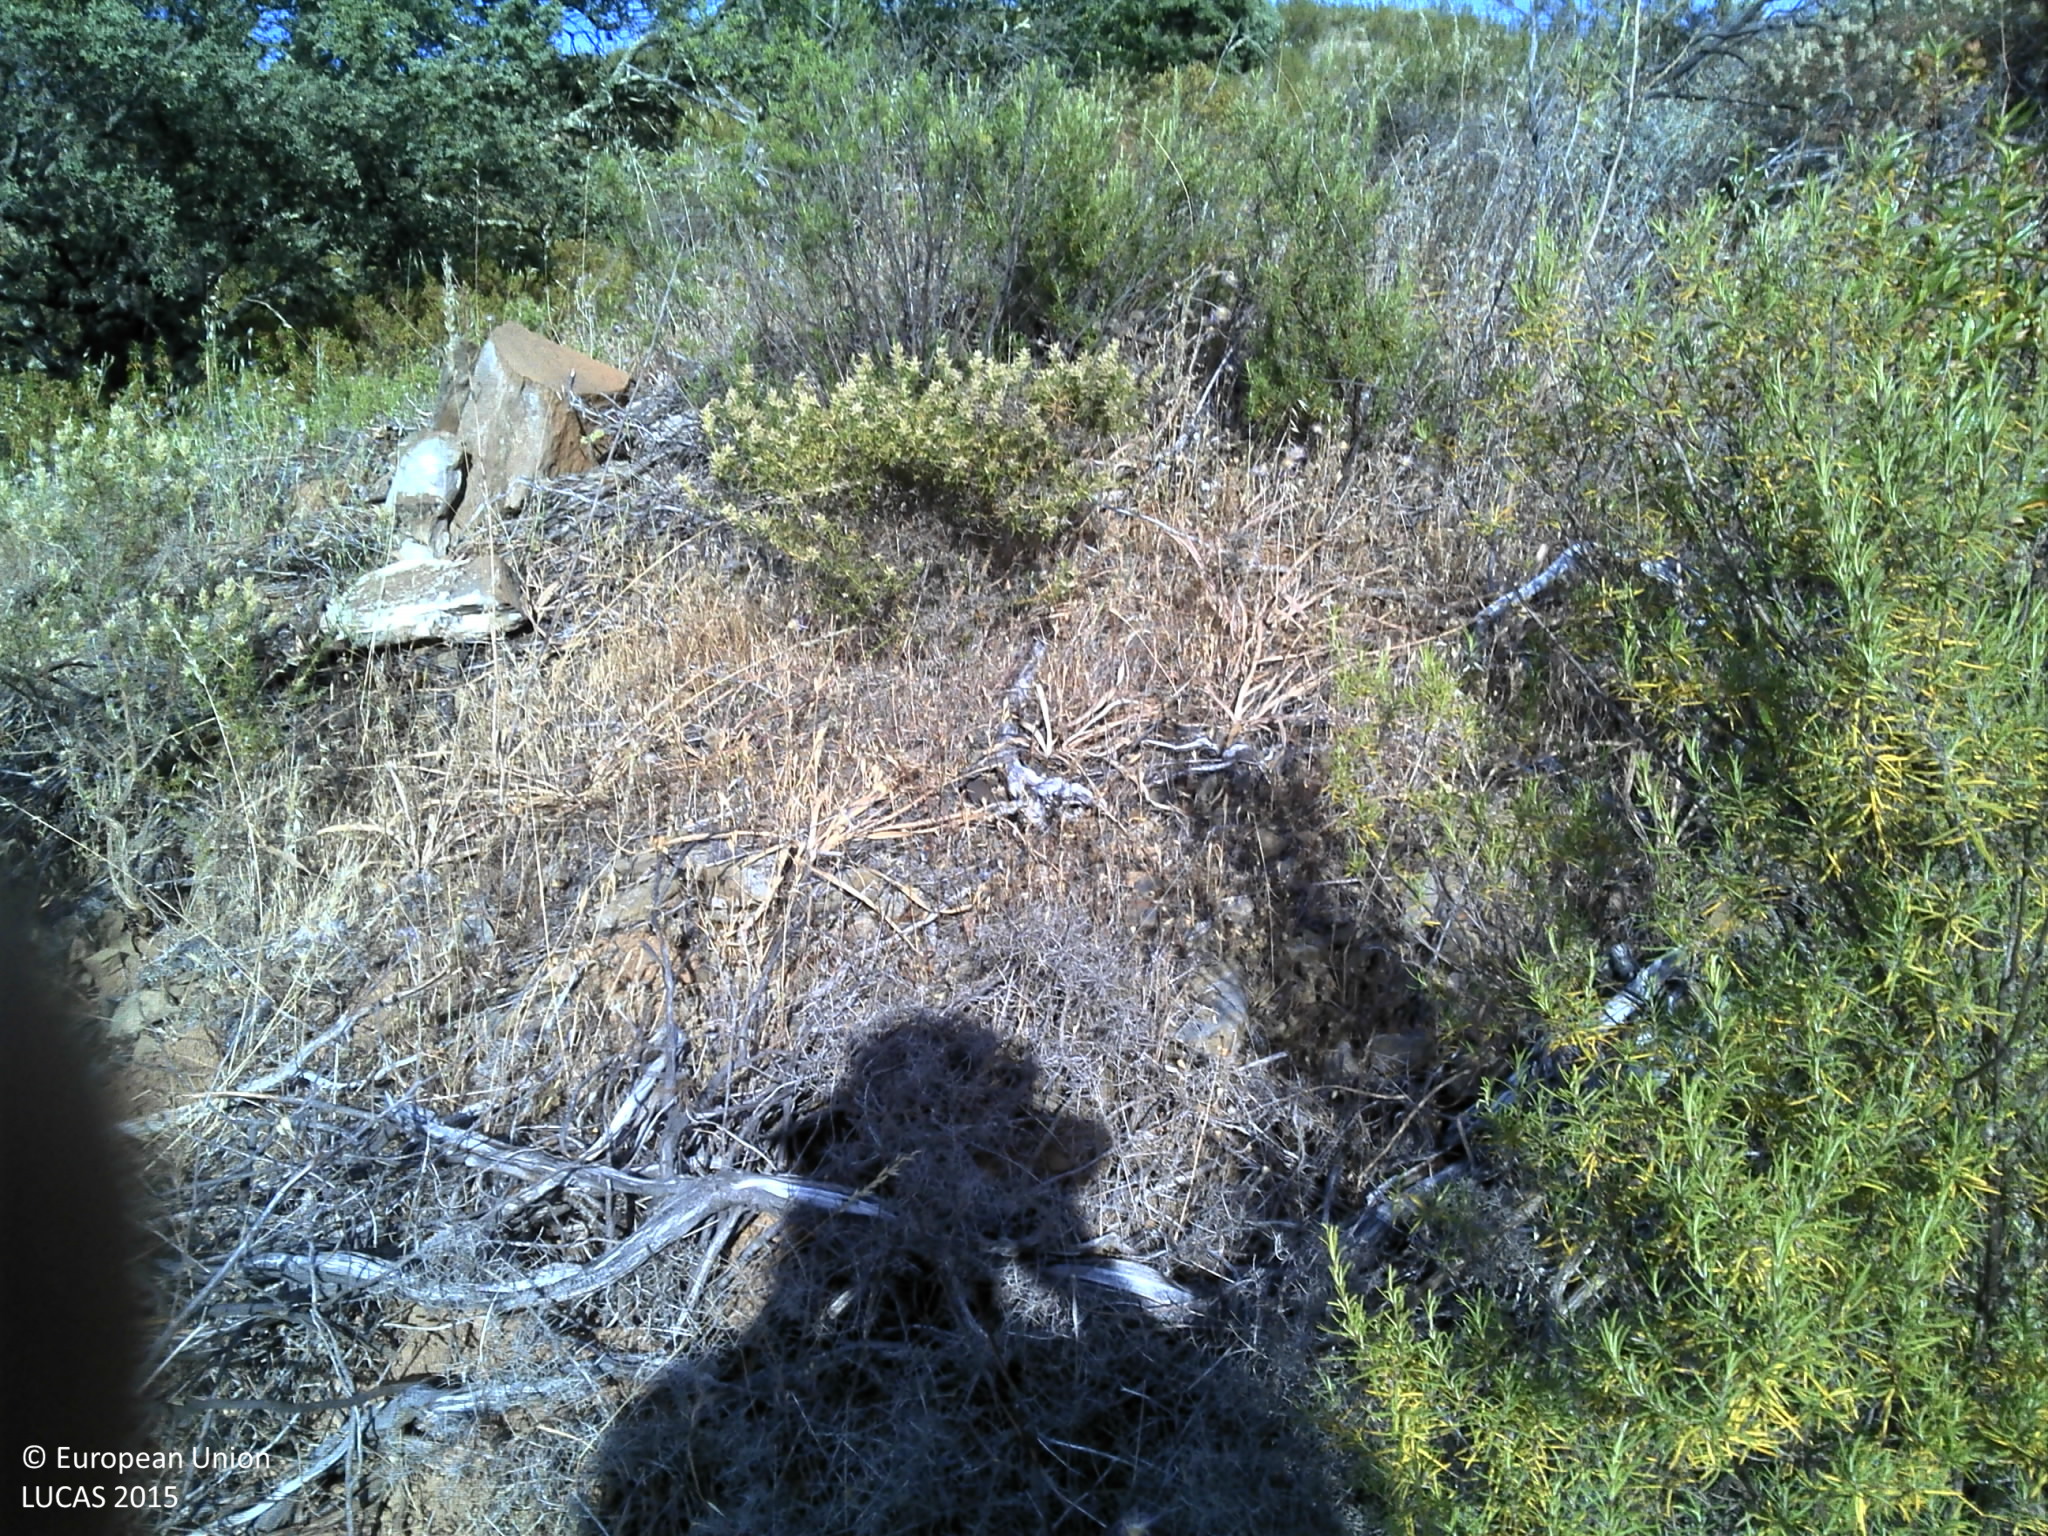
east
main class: Shrubland
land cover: Shrubland with sparse tree cover
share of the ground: 50 - 75 %
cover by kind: shrubs 75 %, unconsolidated bare surface 20 %, broadleaved forest trees 5 %
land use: Abandoned areas
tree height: > 5 m
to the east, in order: Shrubland with sparse tree cover; Shrubland without tree cover; Grassland with sparse tree/shrub cover; Rivers and streams; Grass margins; Pine dominated coniferous woodland
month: May
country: PT
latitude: 37.2987
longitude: -7.4794
